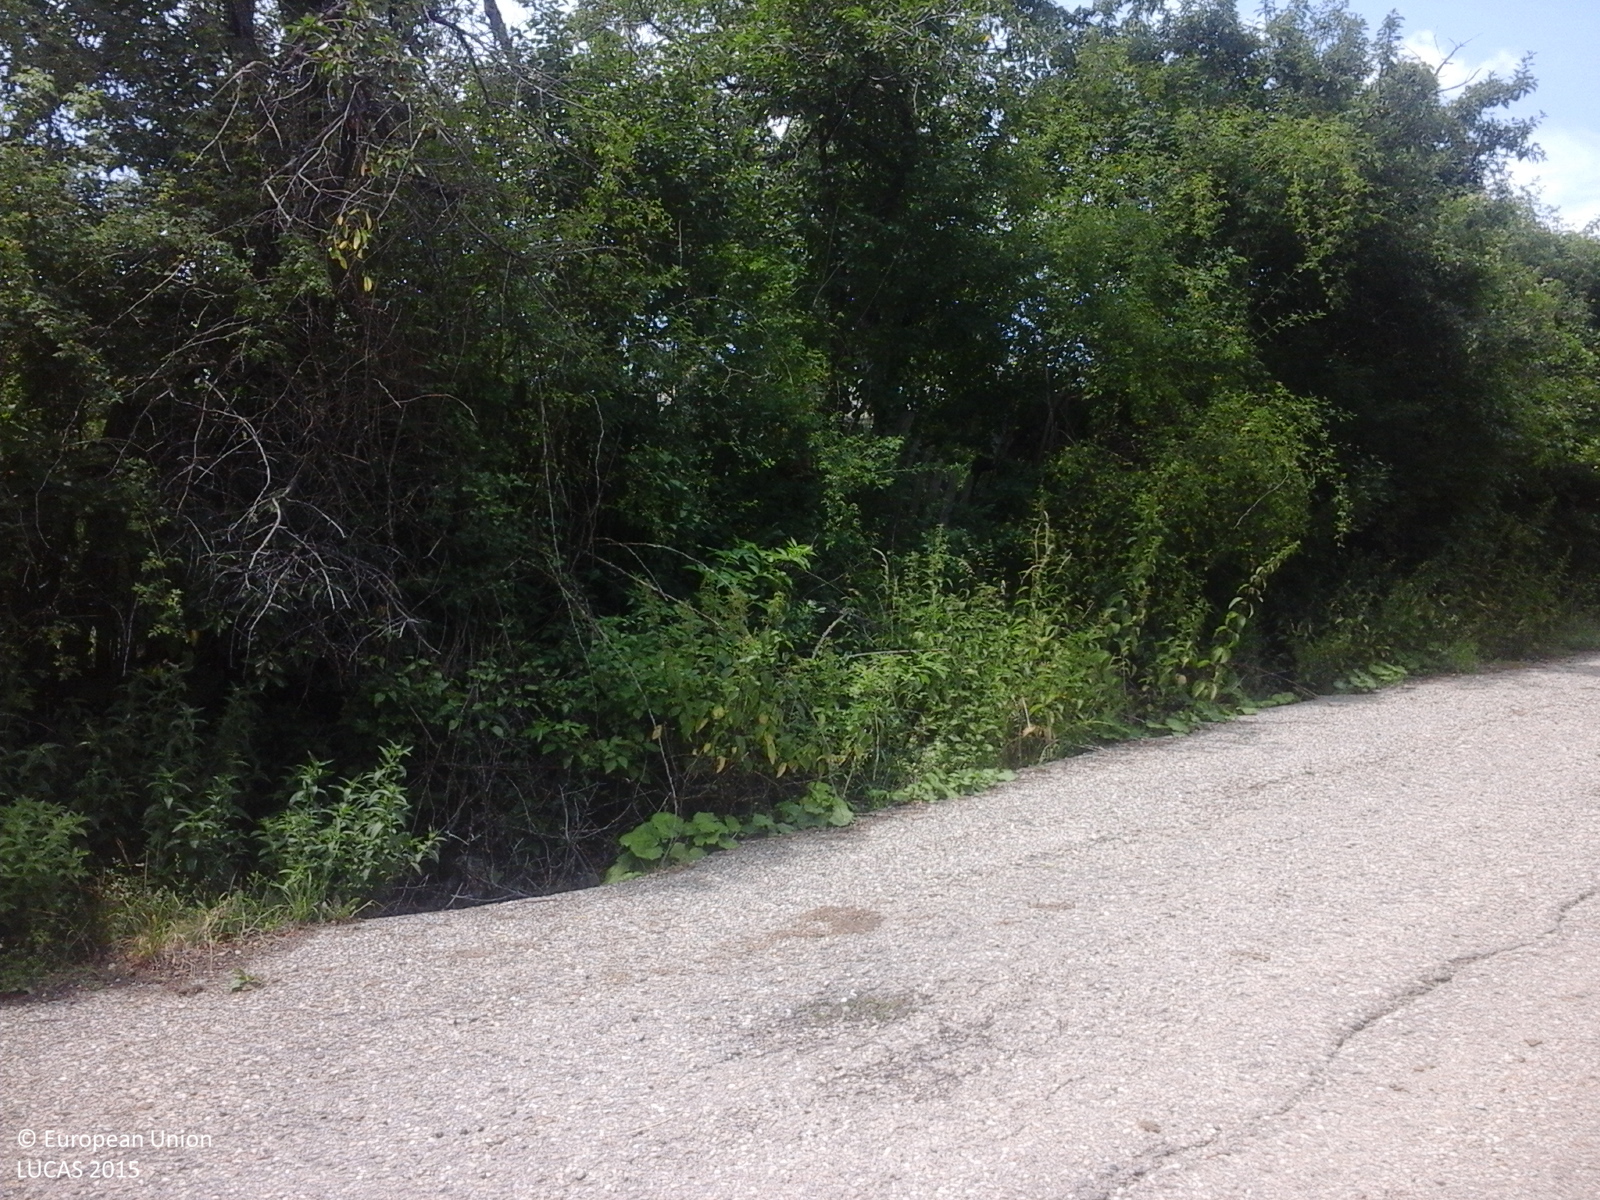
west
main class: Cropland
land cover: Other fruit trees and berries
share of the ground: 50 - 75 %
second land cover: Grassland without tree/shrub cover
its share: 50 - 75 %
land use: Agriculture (excluding fallow land and kitchen gardens)
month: July
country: RO
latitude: 45.3369
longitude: 24.7714
